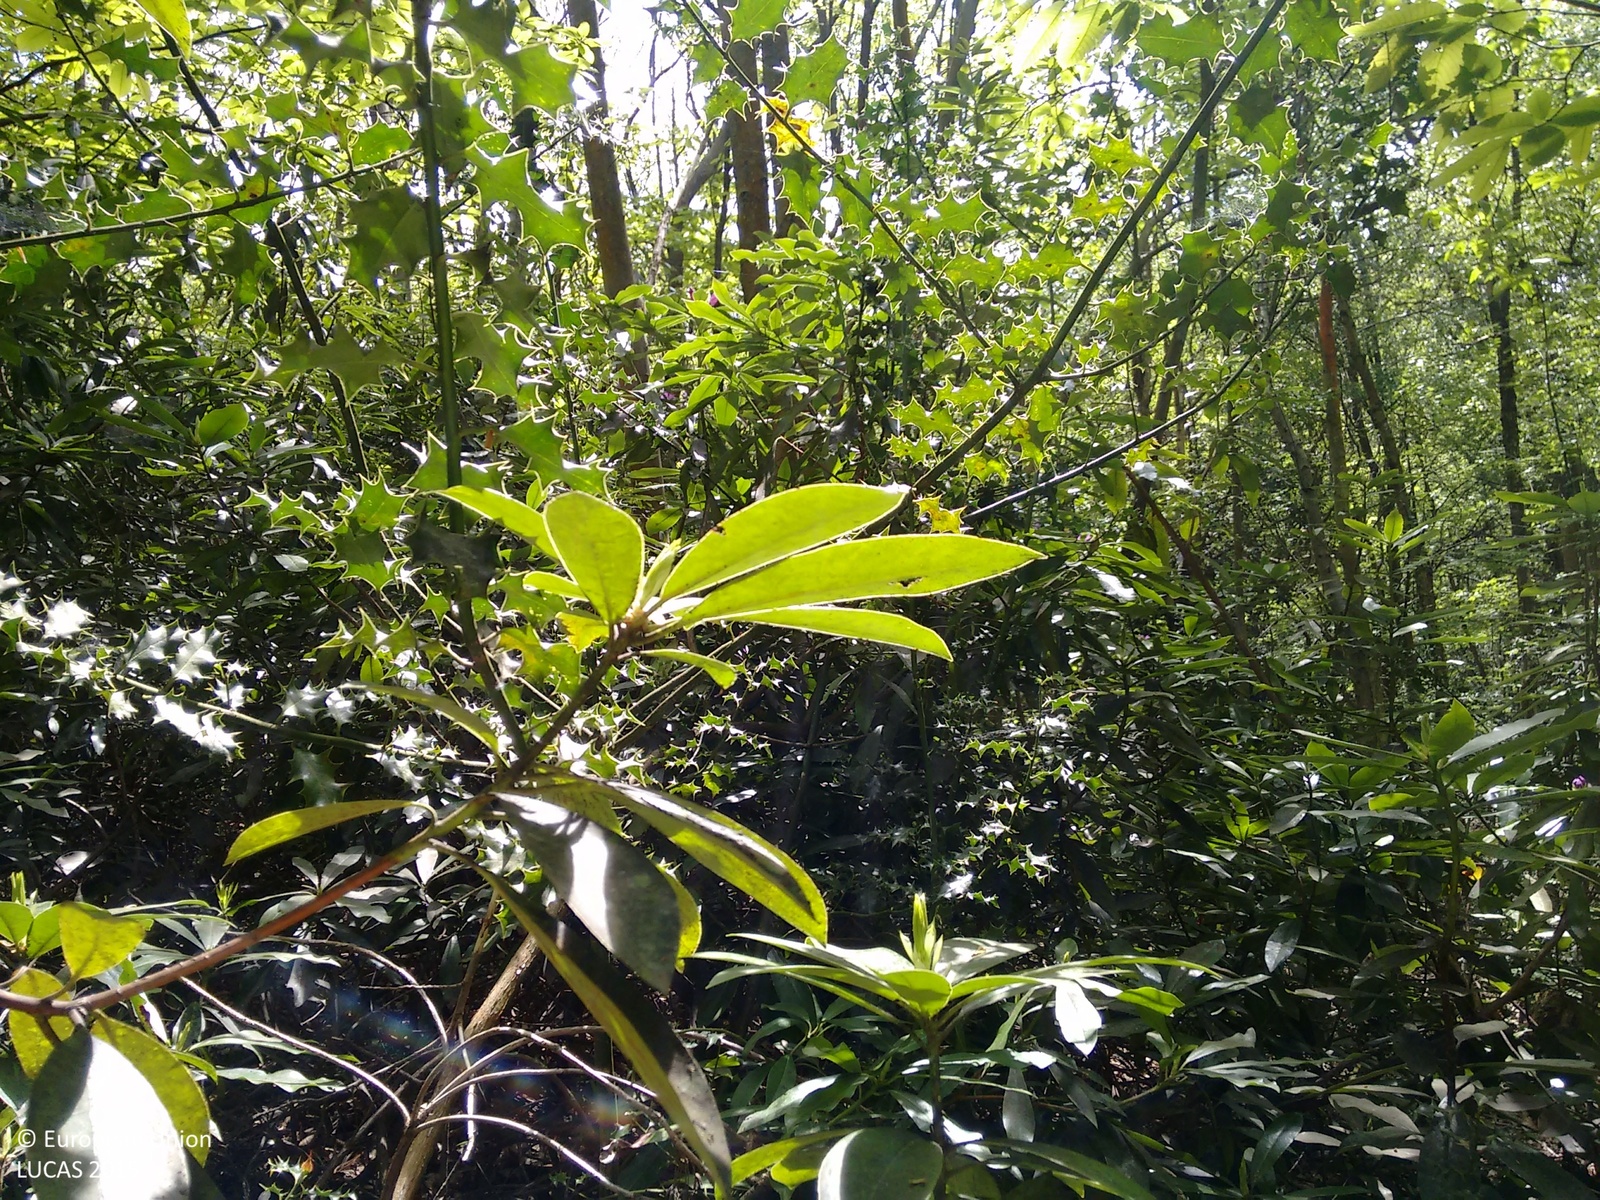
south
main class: Woodland
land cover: Broadleaved woodland
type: exotic forest
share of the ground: > 75 %
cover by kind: broadleaved forest trees 50 %, shrubs 50 %
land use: Amenities, museums, leisure
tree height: > 5 m
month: May
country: GB
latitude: 51.1457
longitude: 0.2927
